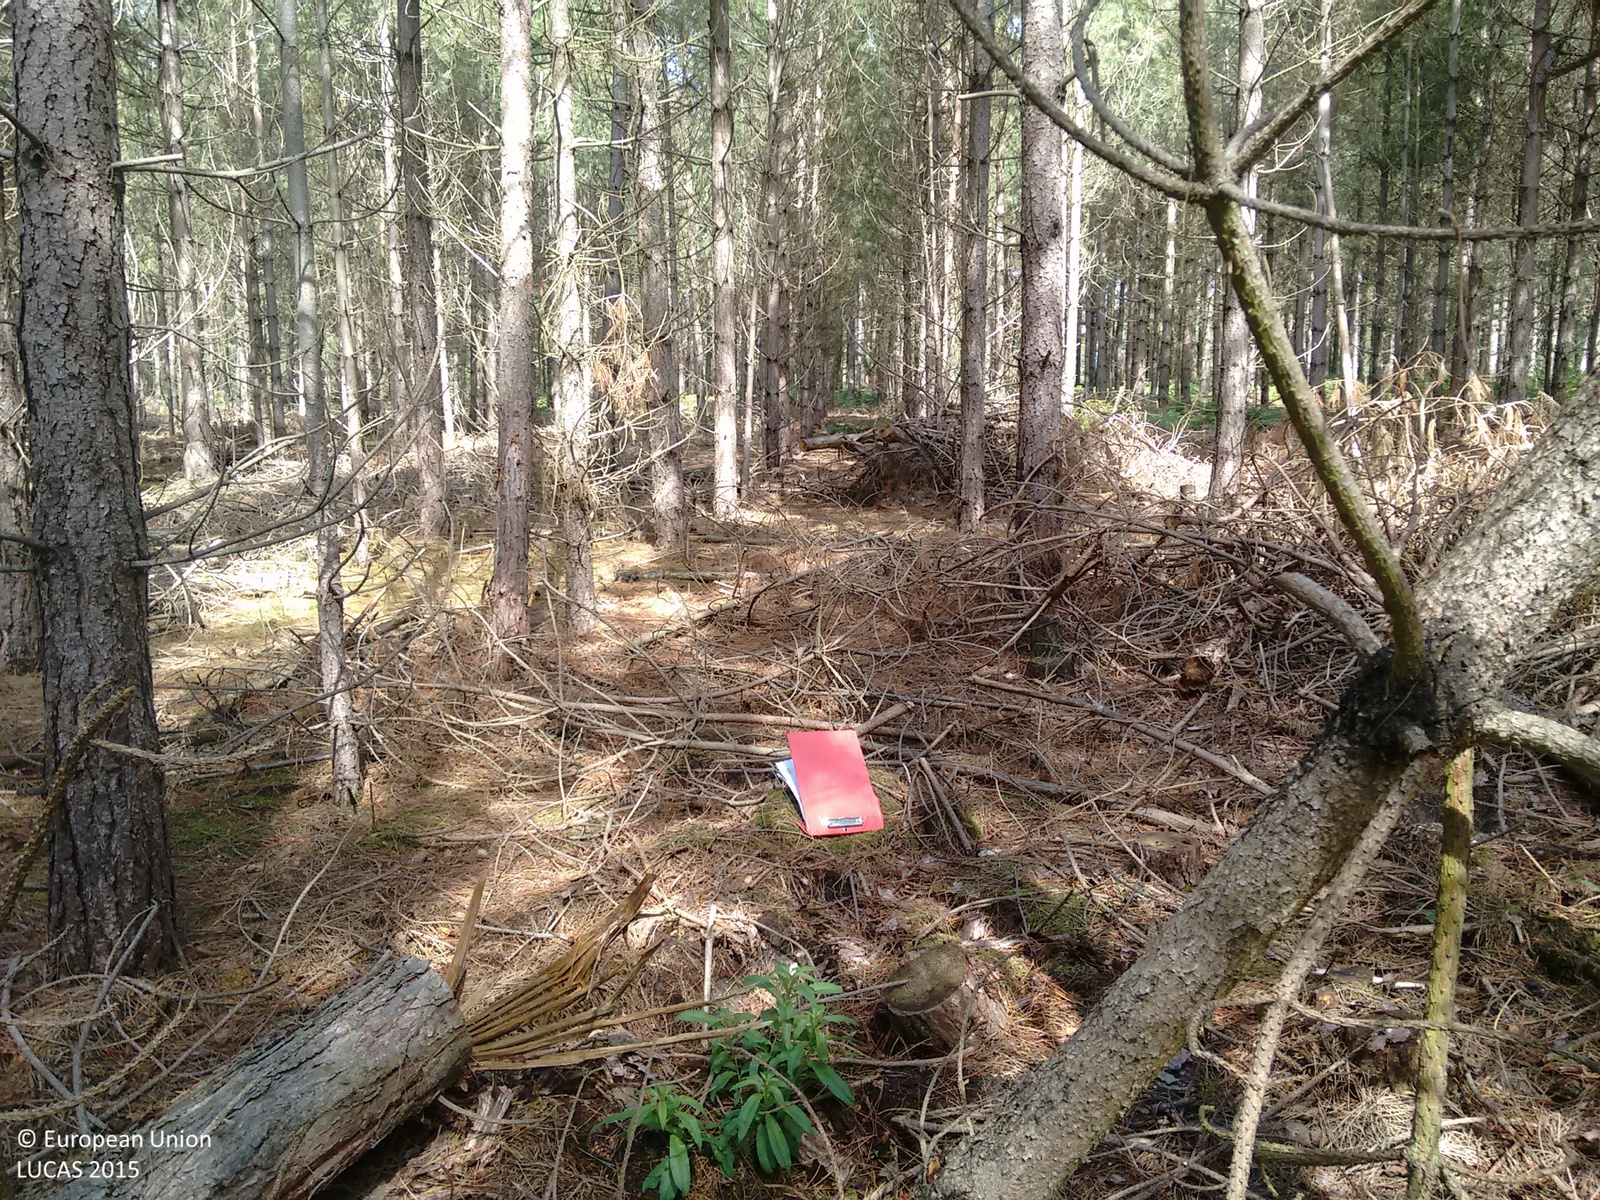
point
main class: Woodland
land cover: Pine dominated coniferous woodland
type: exotic forest
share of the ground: > 75 %
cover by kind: coniferous forest trees 90 %, herbaceous plants 10 %
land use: Forestry
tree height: > 5 m
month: August
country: GB
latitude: 52.0862
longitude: 1.4429
